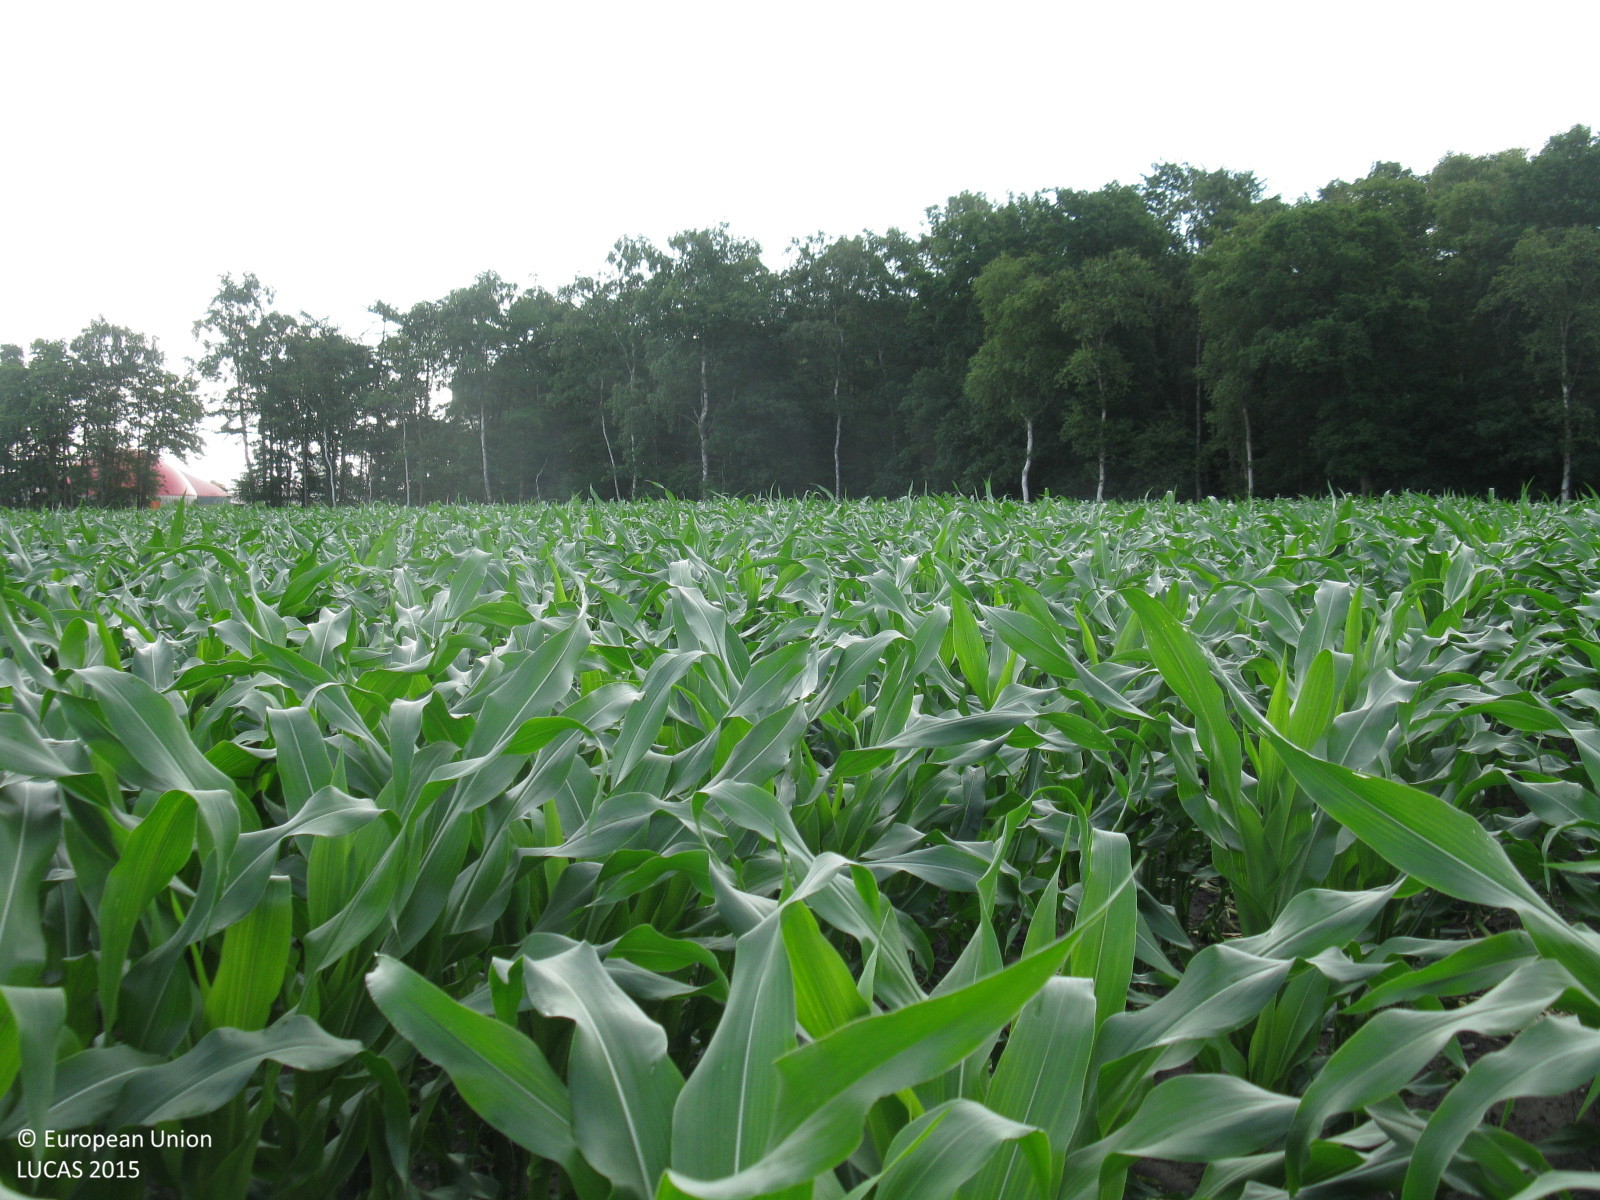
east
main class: Cropland
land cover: Maize
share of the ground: > 75 %
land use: Agriculture (excluding fallow land and kitchen gardens)
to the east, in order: Maize; Broadleaved woodland; Maize
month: July
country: DE
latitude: 53.4193
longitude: 7.8791
